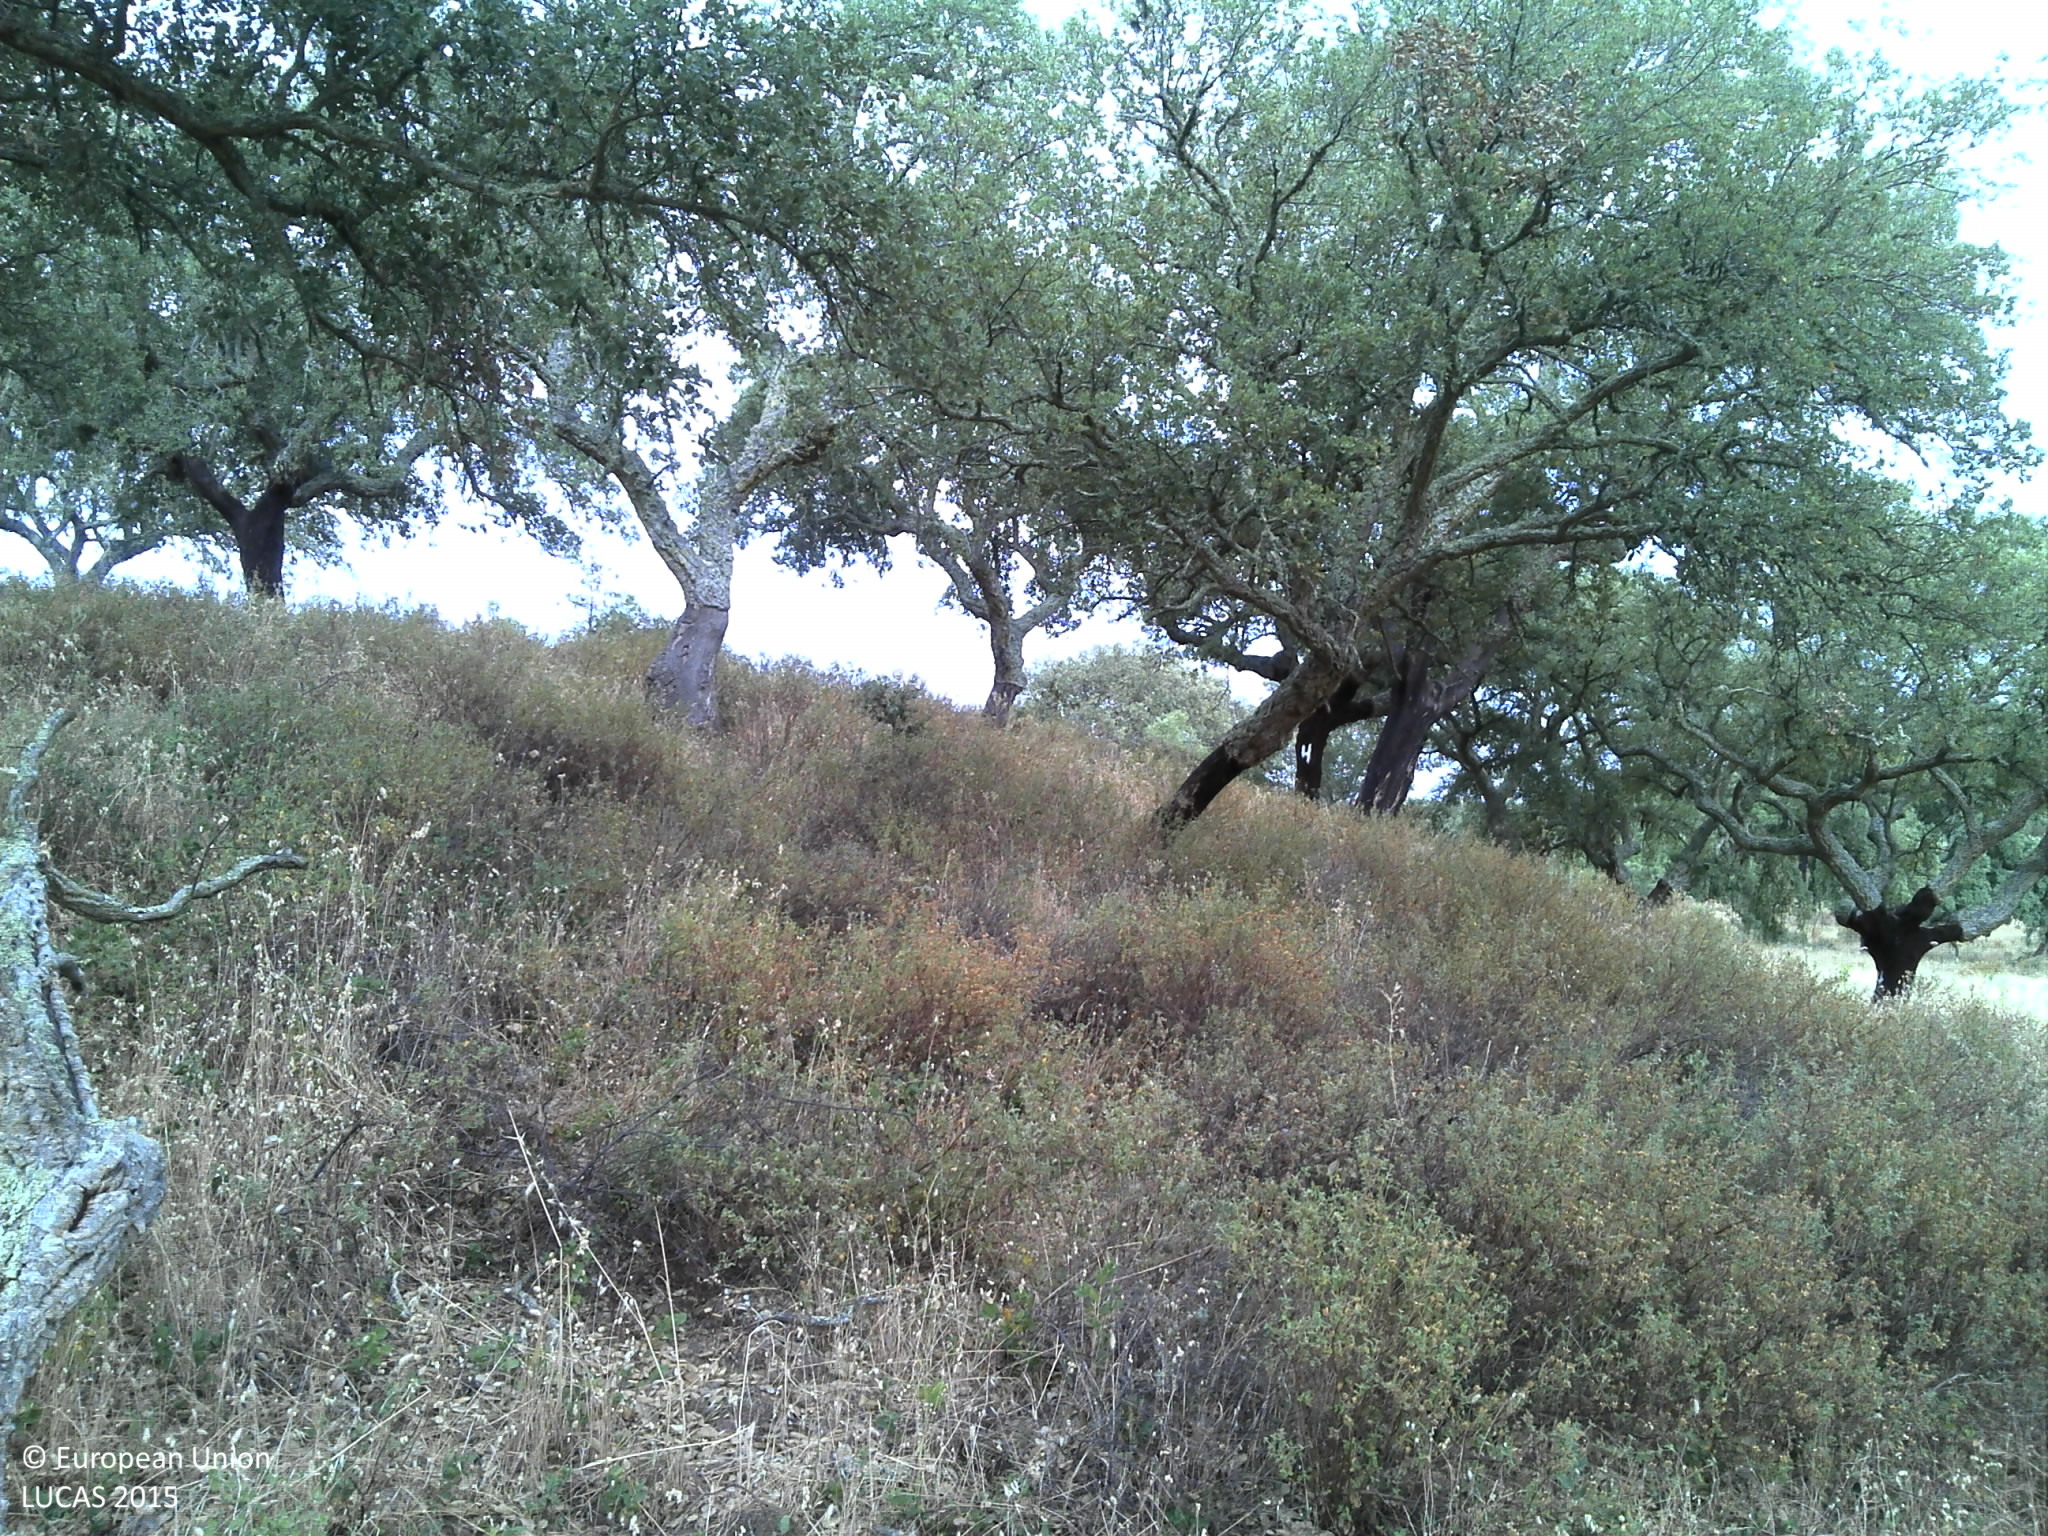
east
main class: Woodland
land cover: Broadleaved woodland
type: broadleaved evergreen forest
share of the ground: 25 - 50 %
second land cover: Grassland without tree/shrub cover
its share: 25 - 50 %
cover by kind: unconsolidated bare surface 35 %, herbaceous plants 30 %, broadleaved forest trees 25 %, shrubs 10 %
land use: Forestry
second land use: Agriculture (excluding fallow land and kitchen gardens)
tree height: > 5 m
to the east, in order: Broadleaved woodland; Grassland without tree/shrub cover; Broadleaved woodland; Grassland with sparse tree/shrub cover; Broadleaved woodland; Grassland without tree/shrub cover; Broadleaved woodland; Grassland without tree/shrub cover; Broadleaved woodland
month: June
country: PT
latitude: 38.3864
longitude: -7.7896
